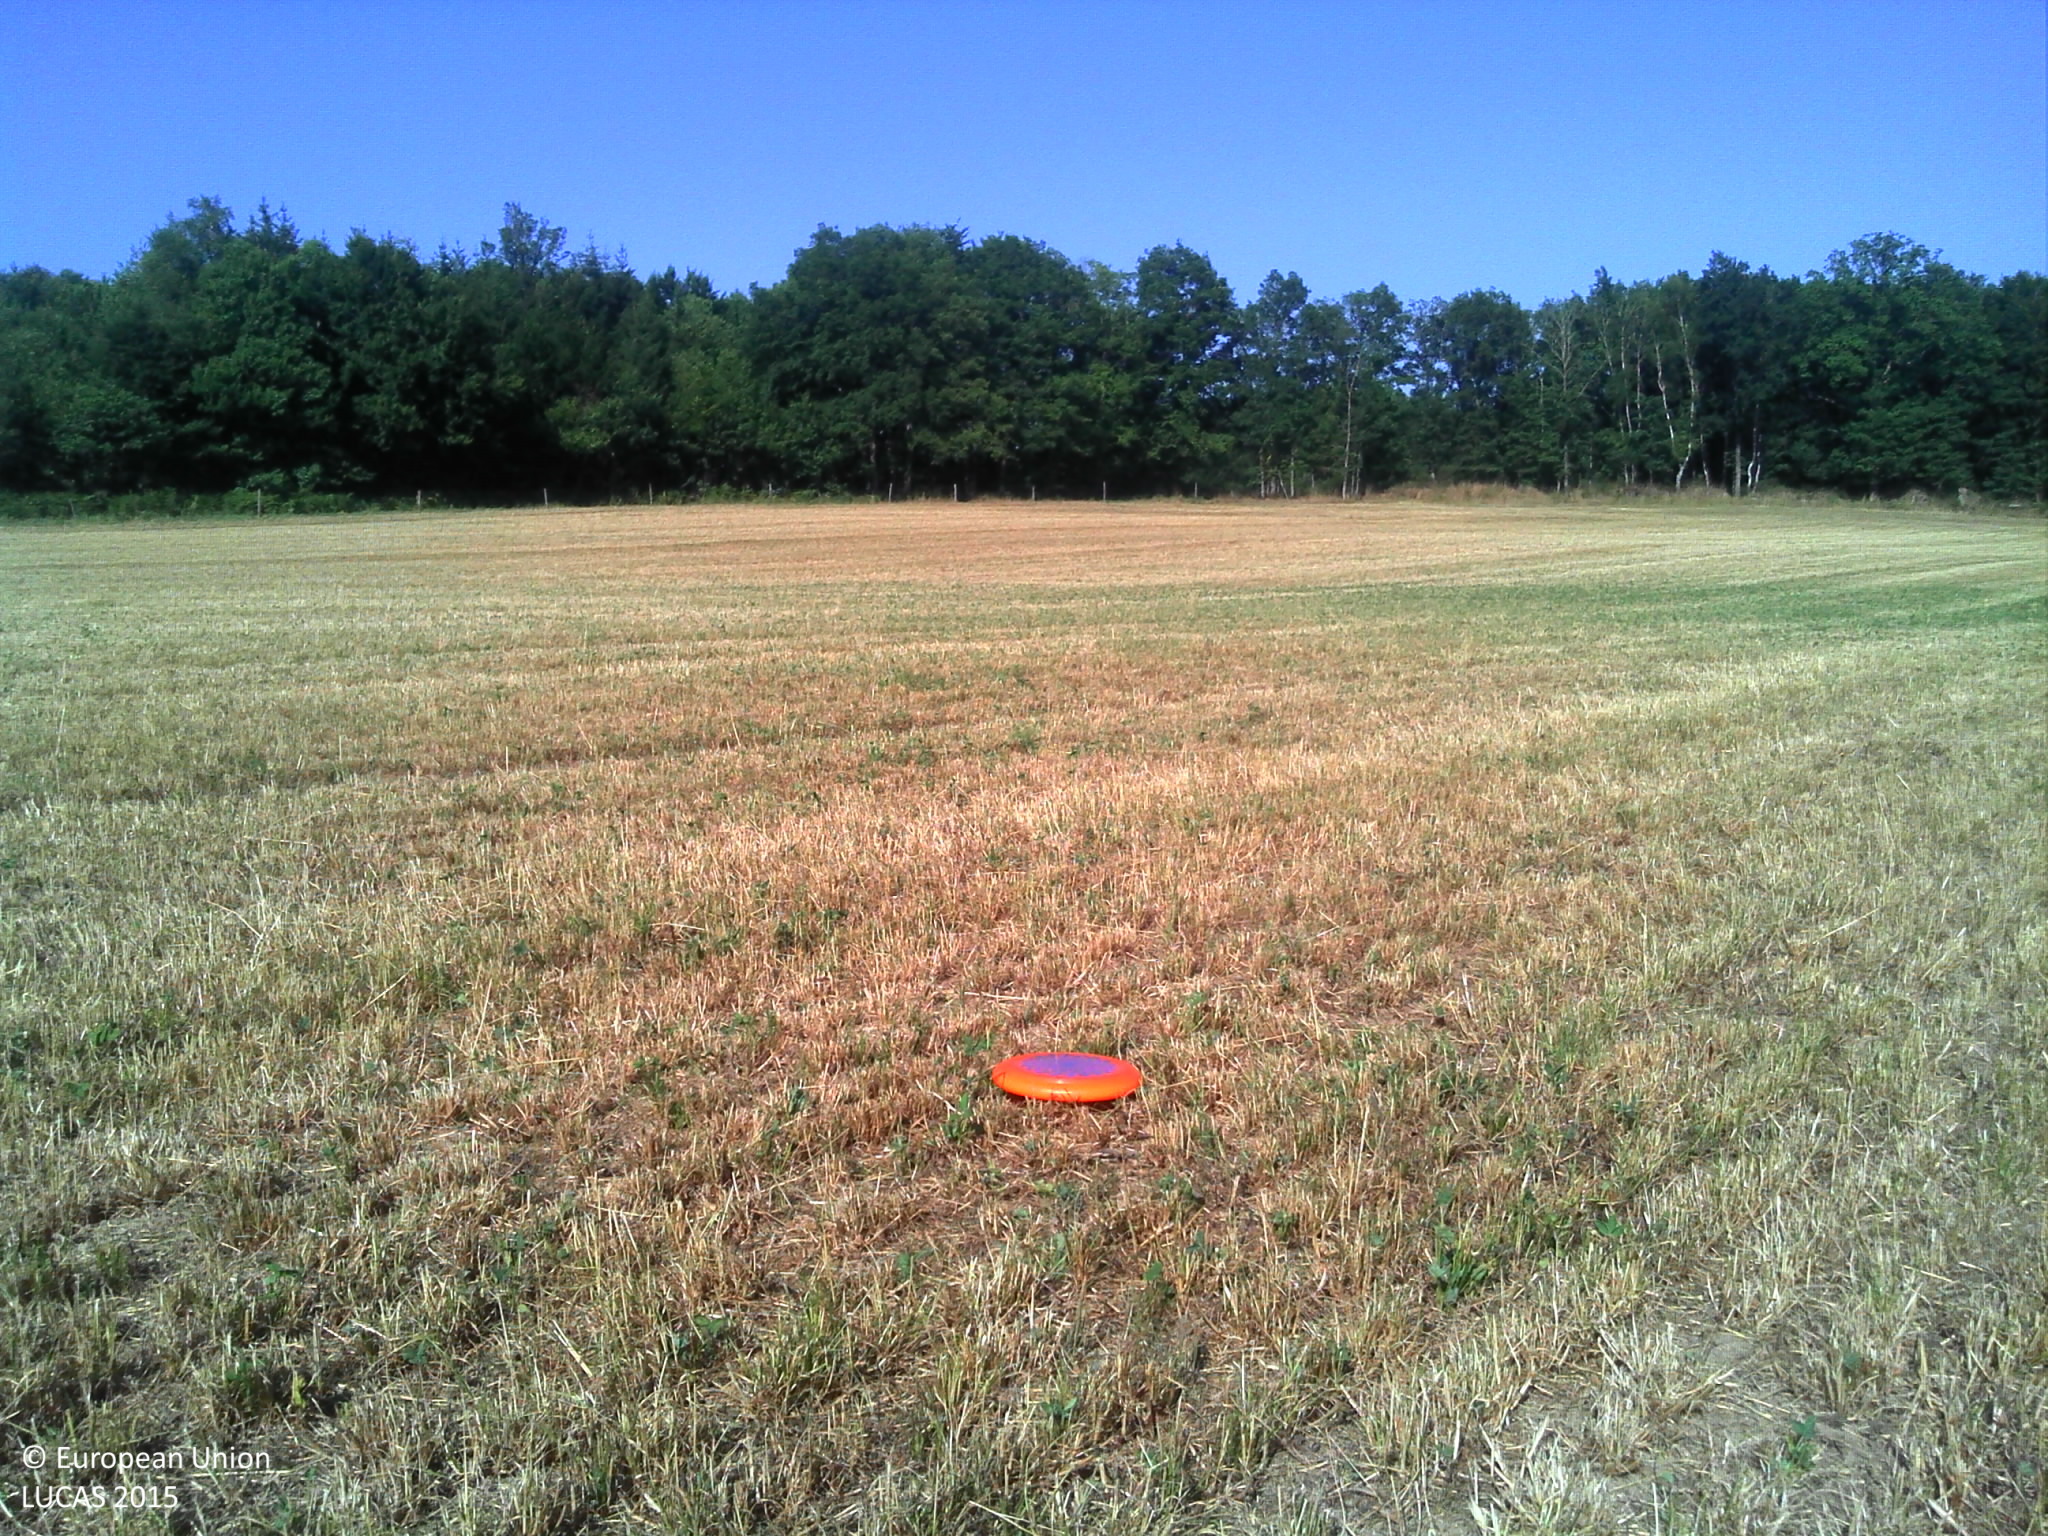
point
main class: Grassland
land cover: Grassland without tree/shrub cover
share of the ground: > 75 %
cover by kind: herbaceous plants 100 %
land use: Agriculture (excluding fallow land and kitchen gardens)
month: July
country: FR
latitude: 46.1226
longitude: 1.7491
